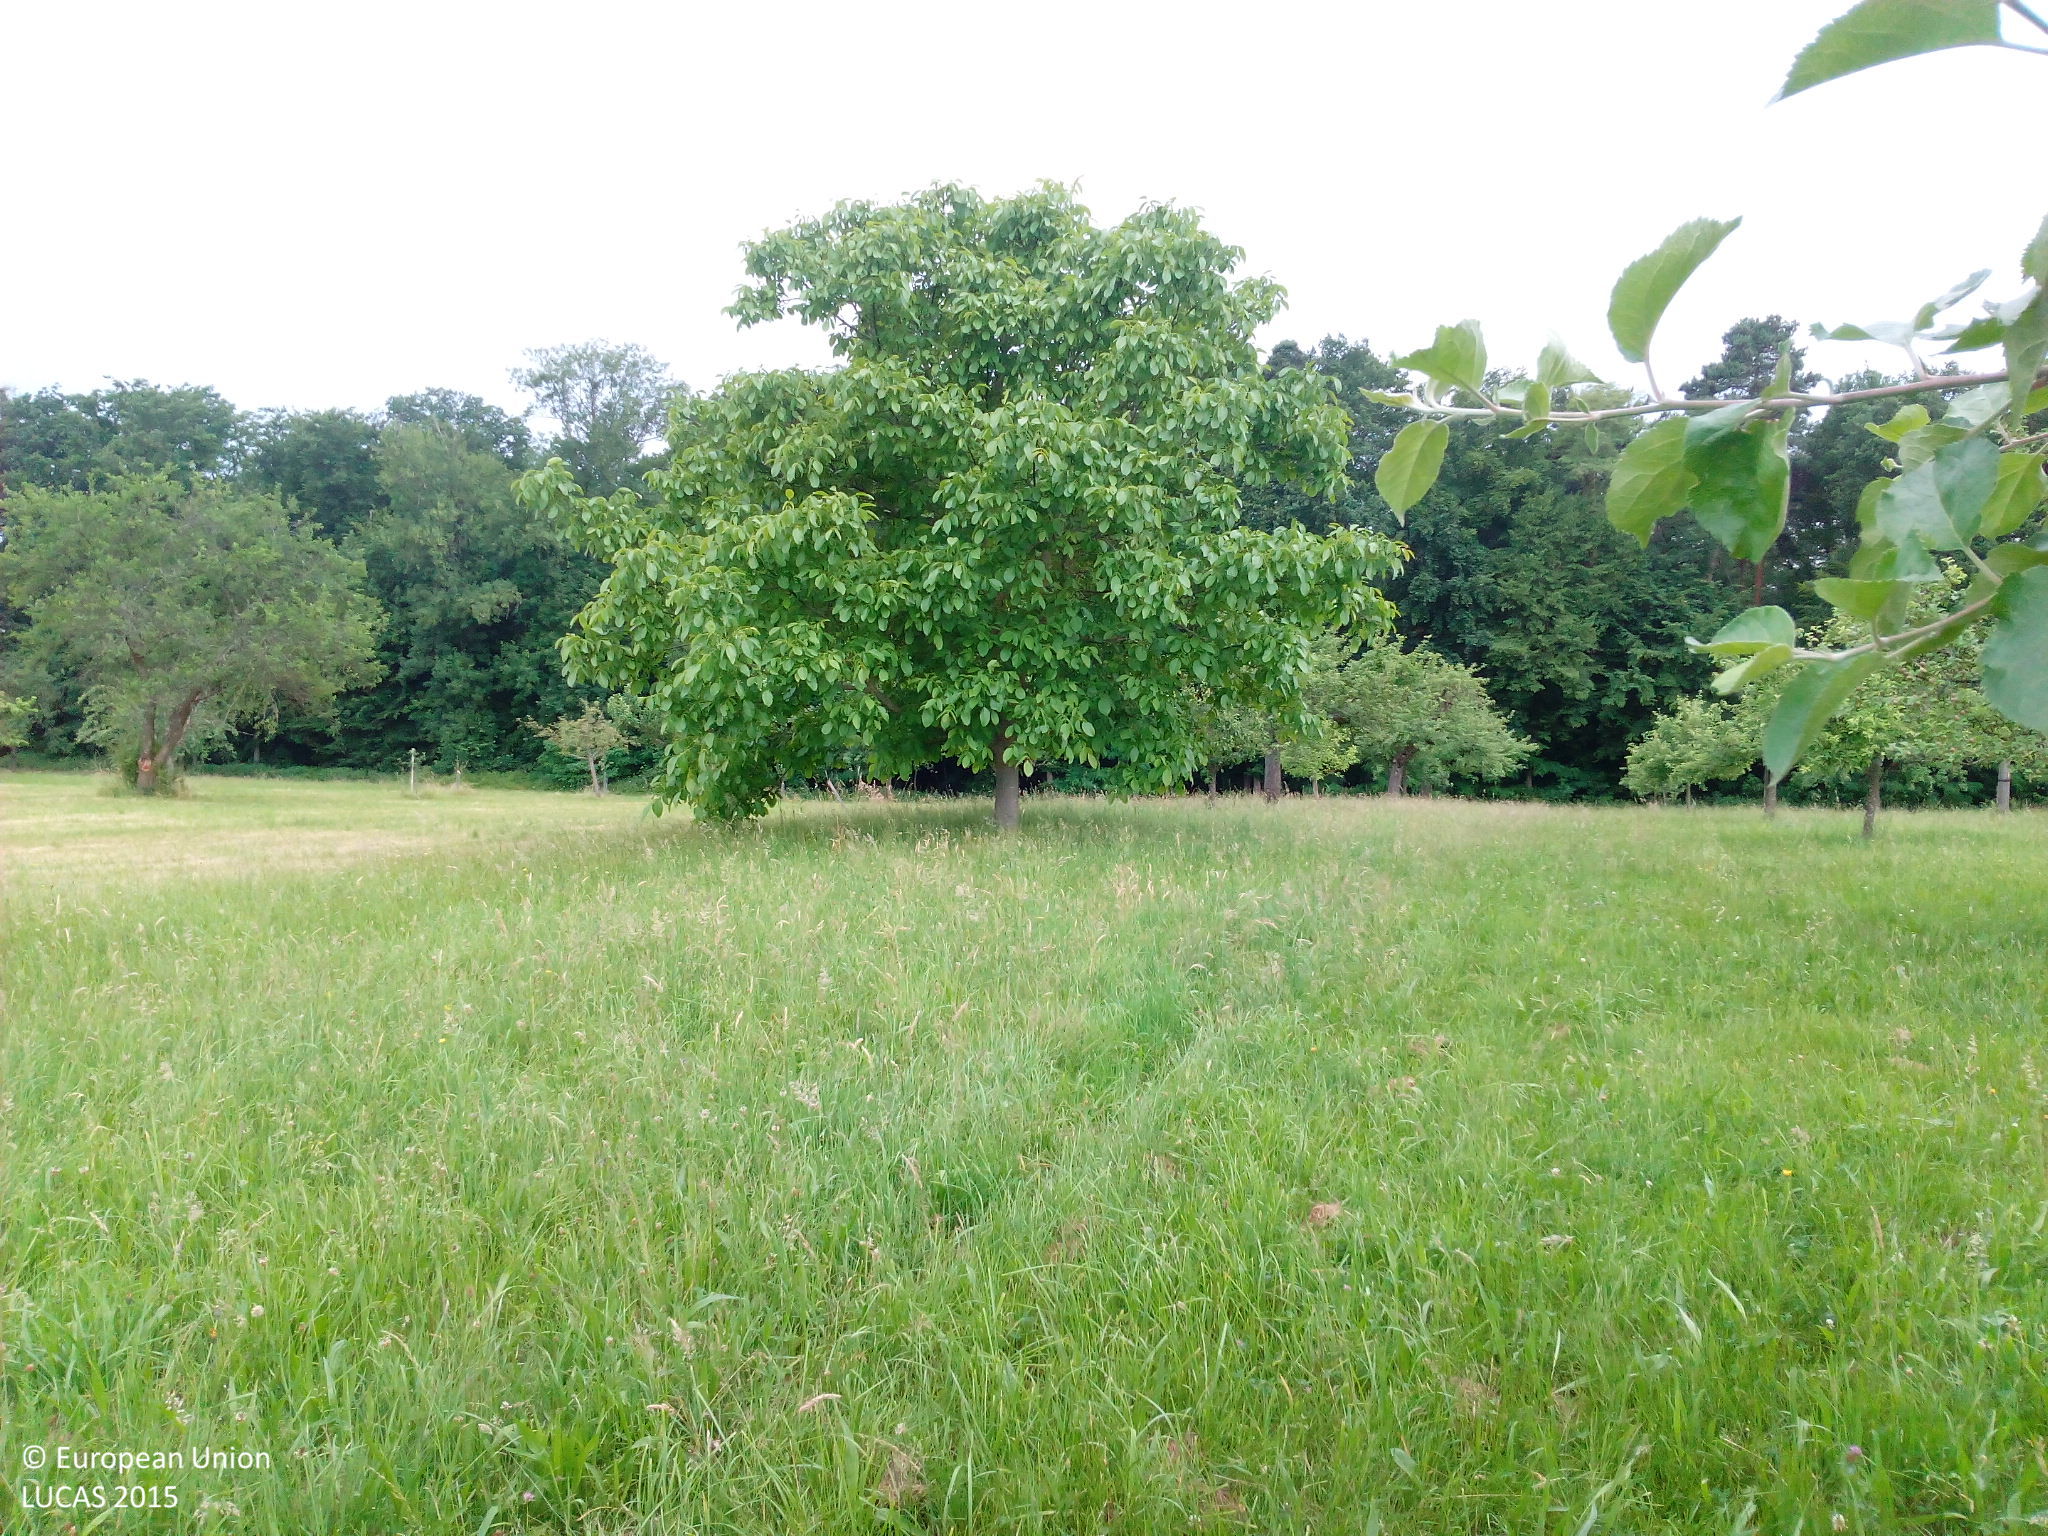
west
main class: Cropland
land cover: Apple fruit
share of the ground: 25 - 50 %
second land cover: Grassland without tree/shrub cover
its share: > 75 %
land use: Agriculture (excluding fallow land and kitchen gardens)
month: June
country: DE
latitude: 48.7616
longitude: 9.3881
